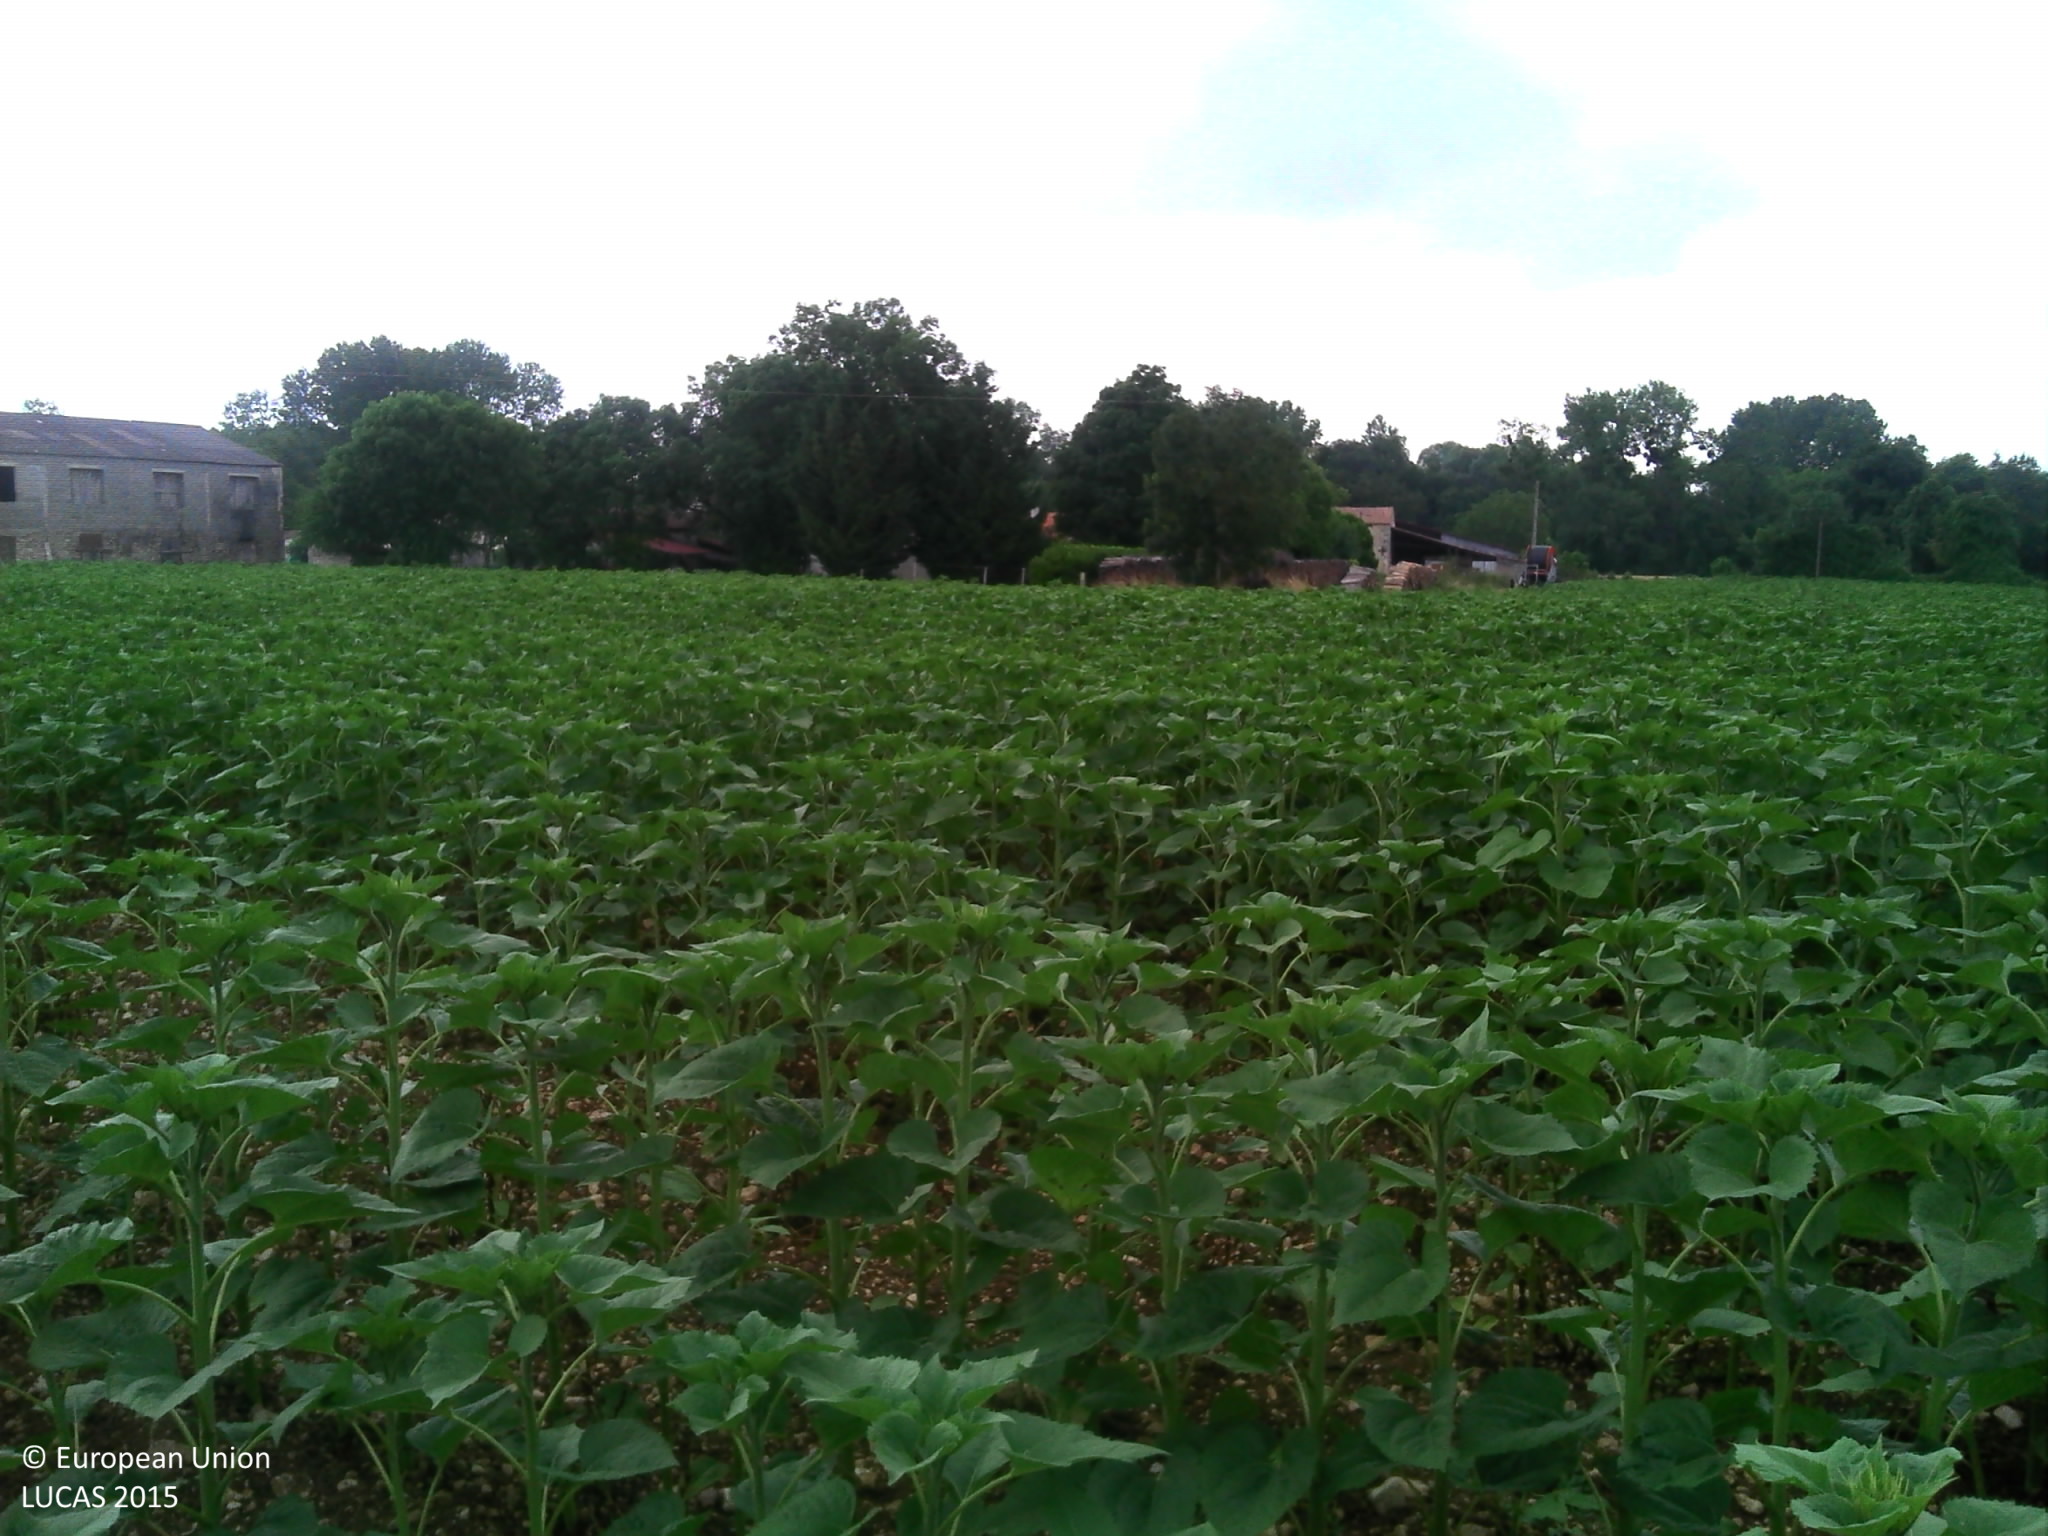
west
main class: Cropland
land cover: Sunflower
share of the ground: > 75 %
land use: Agriculture (excluding fallow land and kitchen gardens)
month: June
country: FR
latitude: 45.9433
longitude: -0.6674
